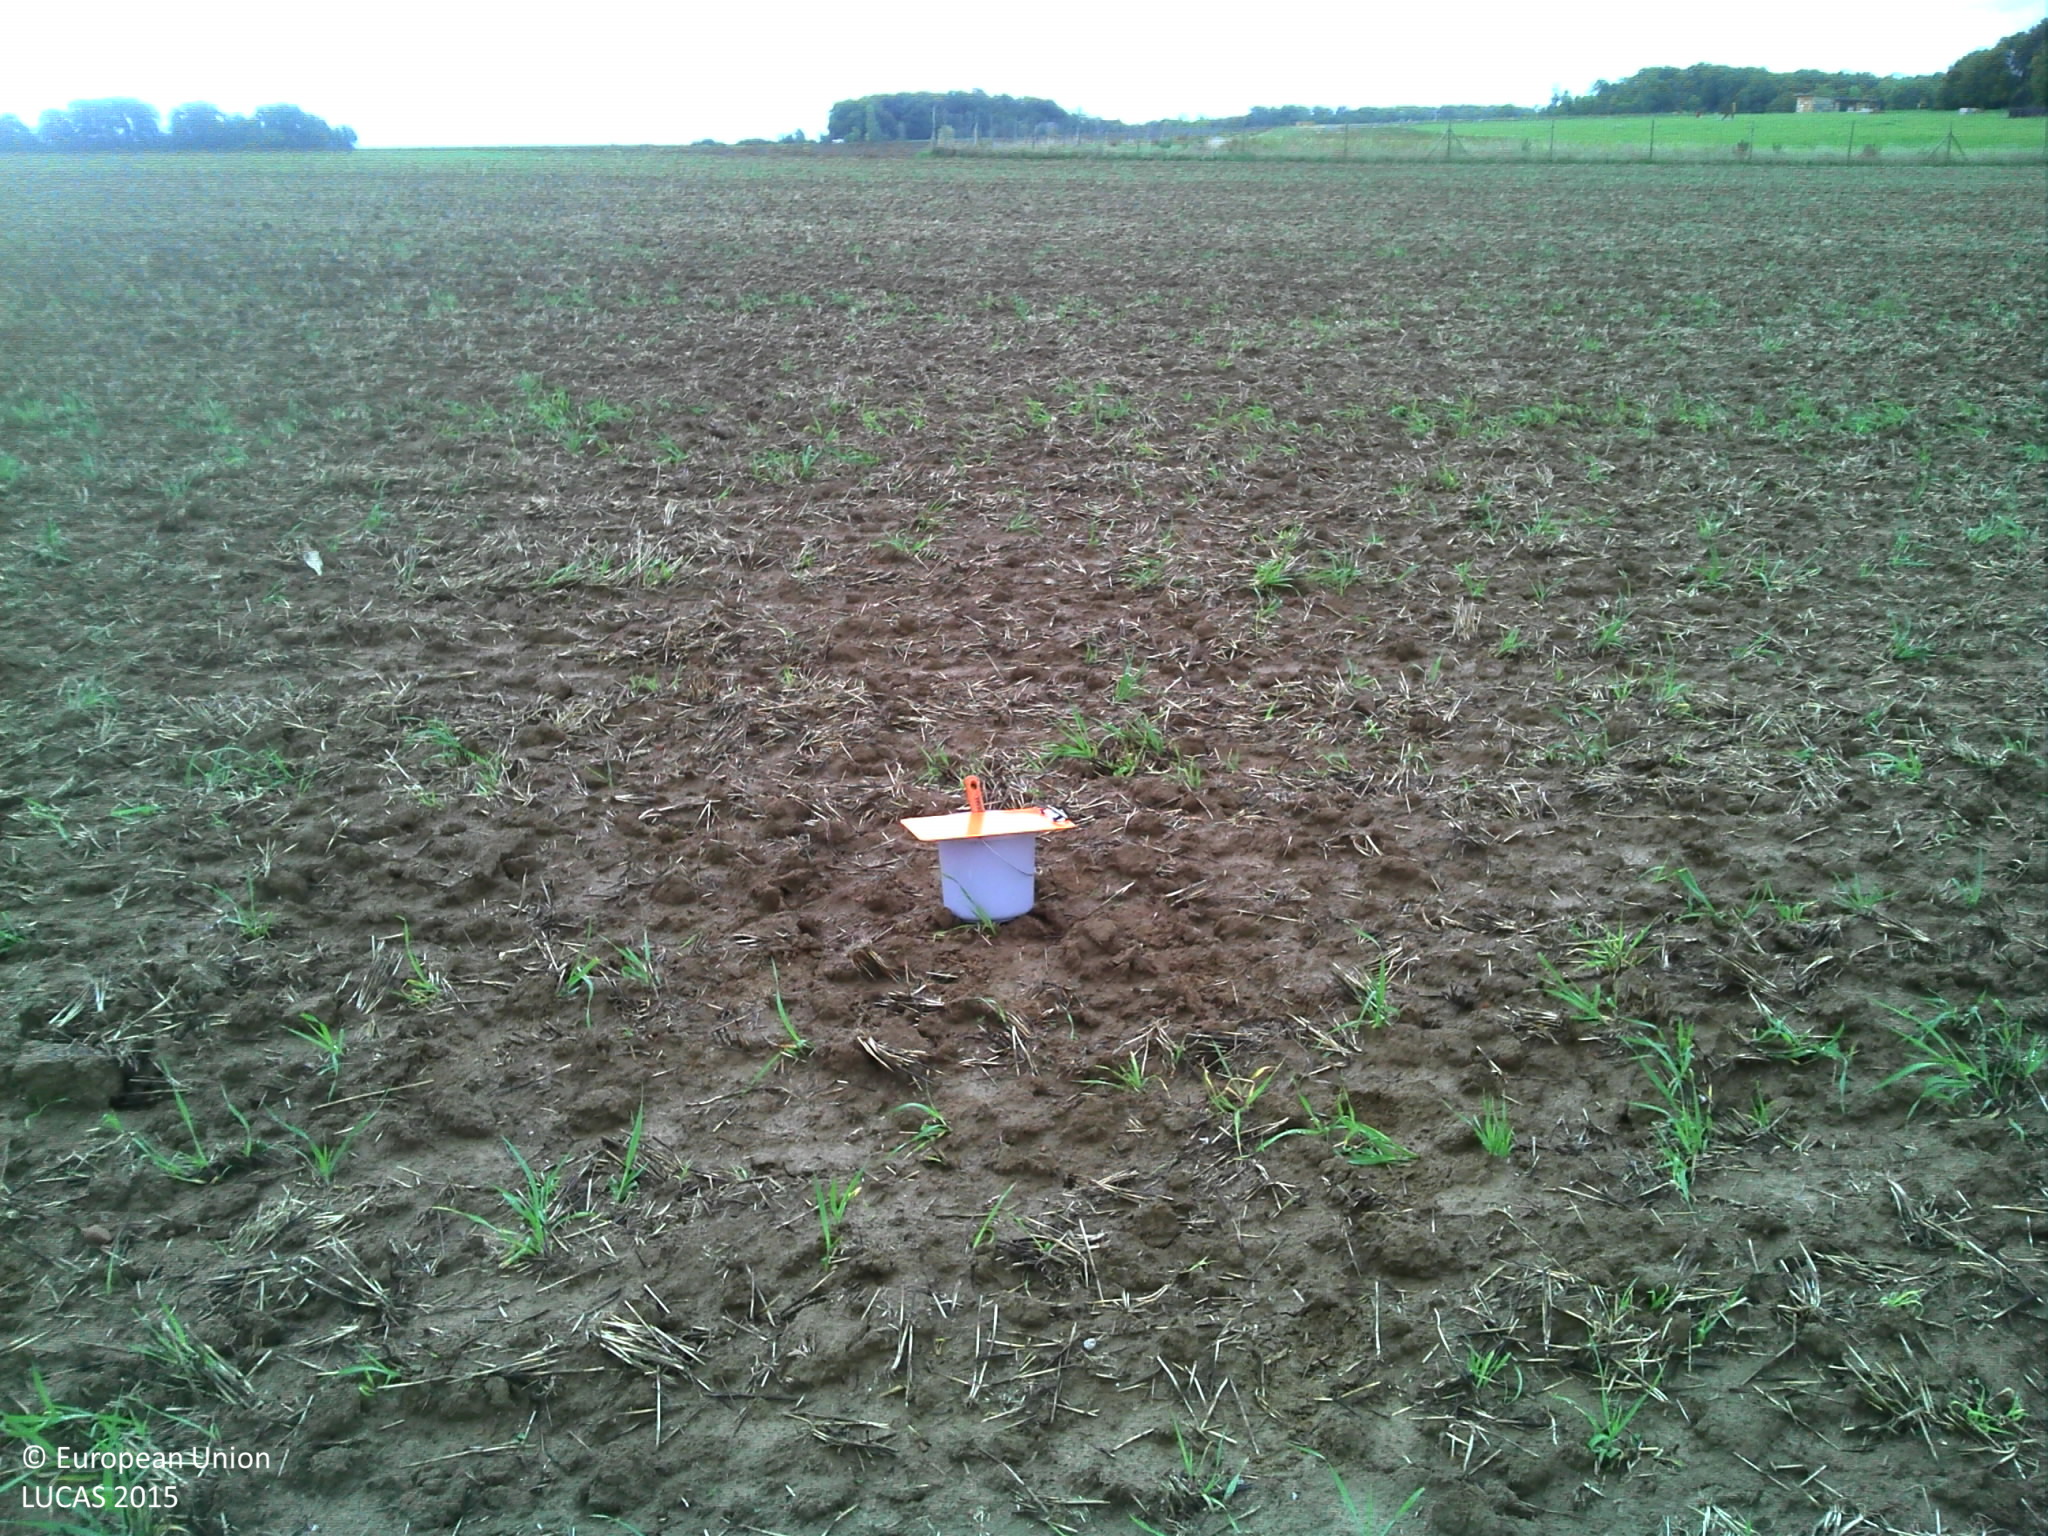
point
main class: Cropland
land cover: Common wheat
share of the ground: 25 - 50 %
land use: Agriculture (excluding fallow land and kitchen gardens)
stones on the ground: < 10 %
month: October
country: FR
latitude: 48.2923
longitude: 4.2955
